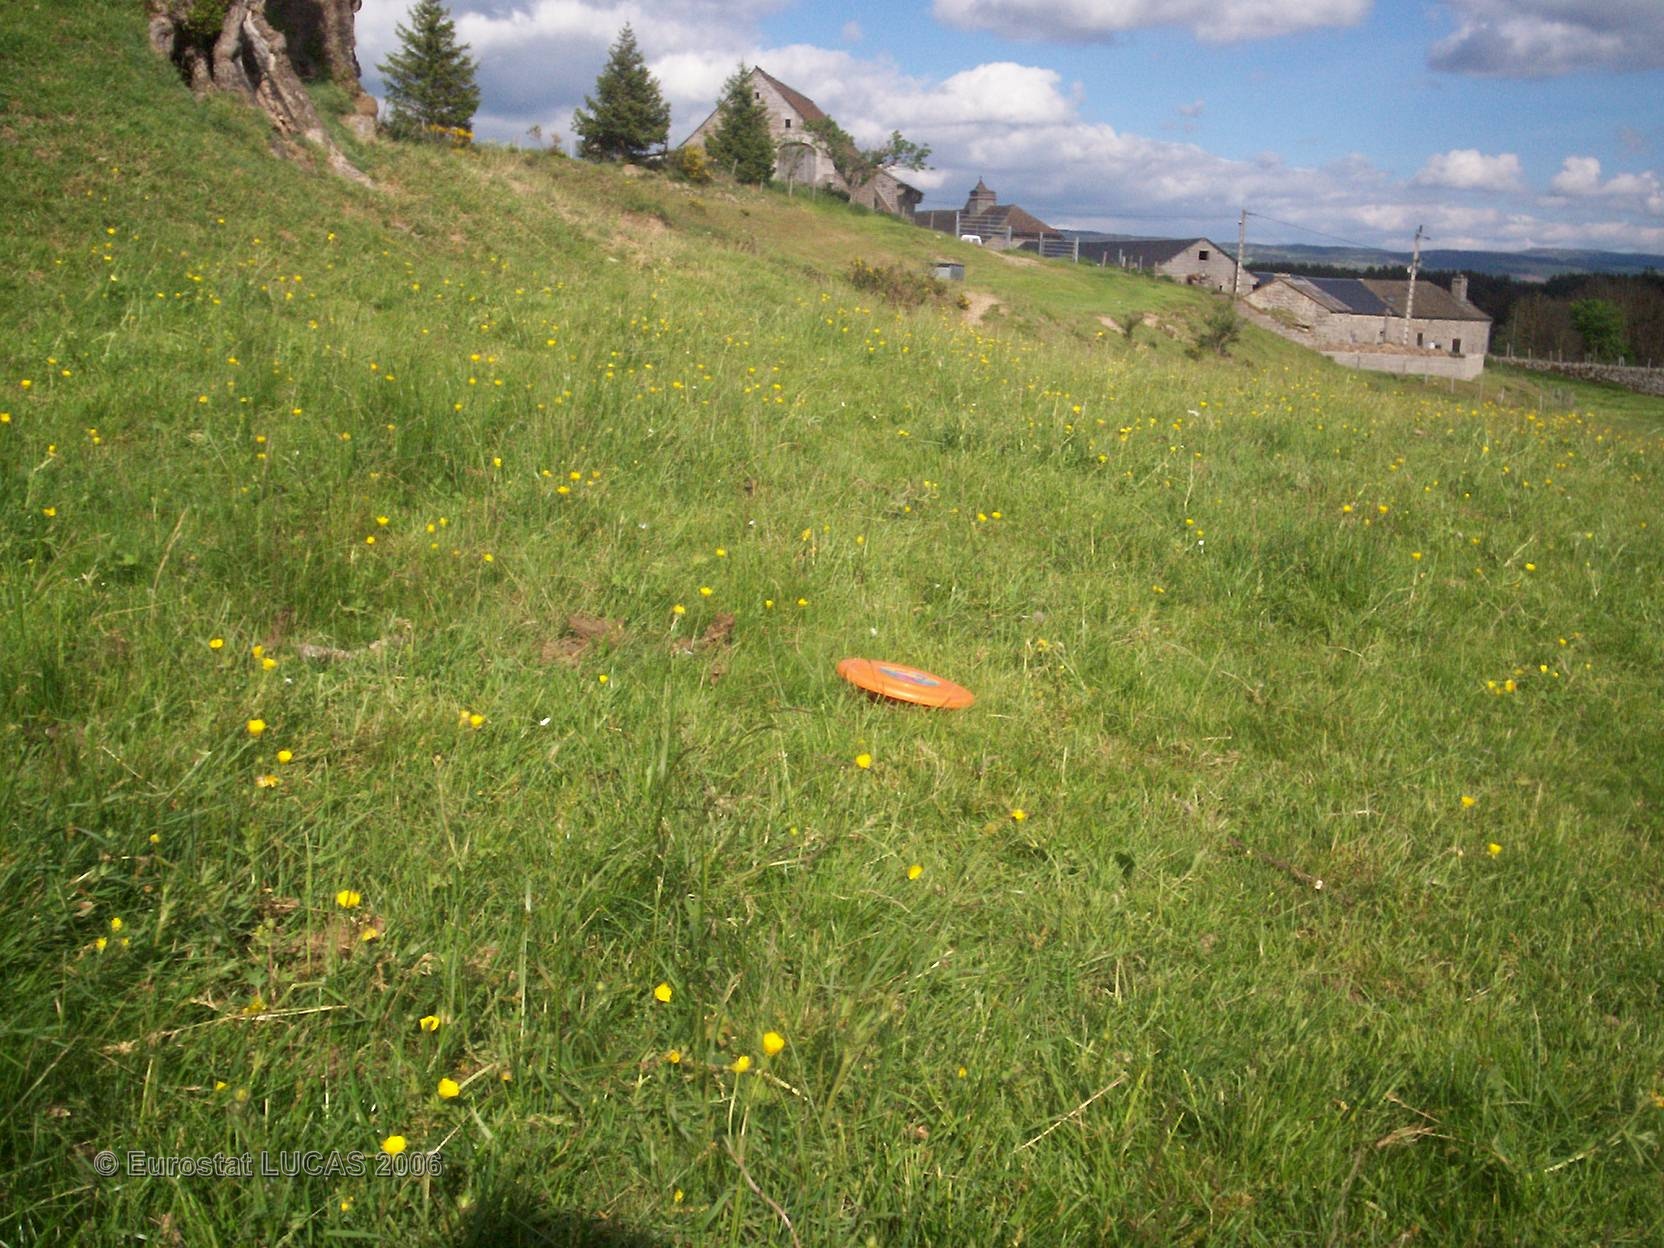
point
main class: Grassland
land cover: Grassland with sparse tree/shrub cover
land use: Agriculture (excluding fallow land and kitchen gardens)
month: May
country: FR
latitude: 44.7177
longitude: 3.3766
